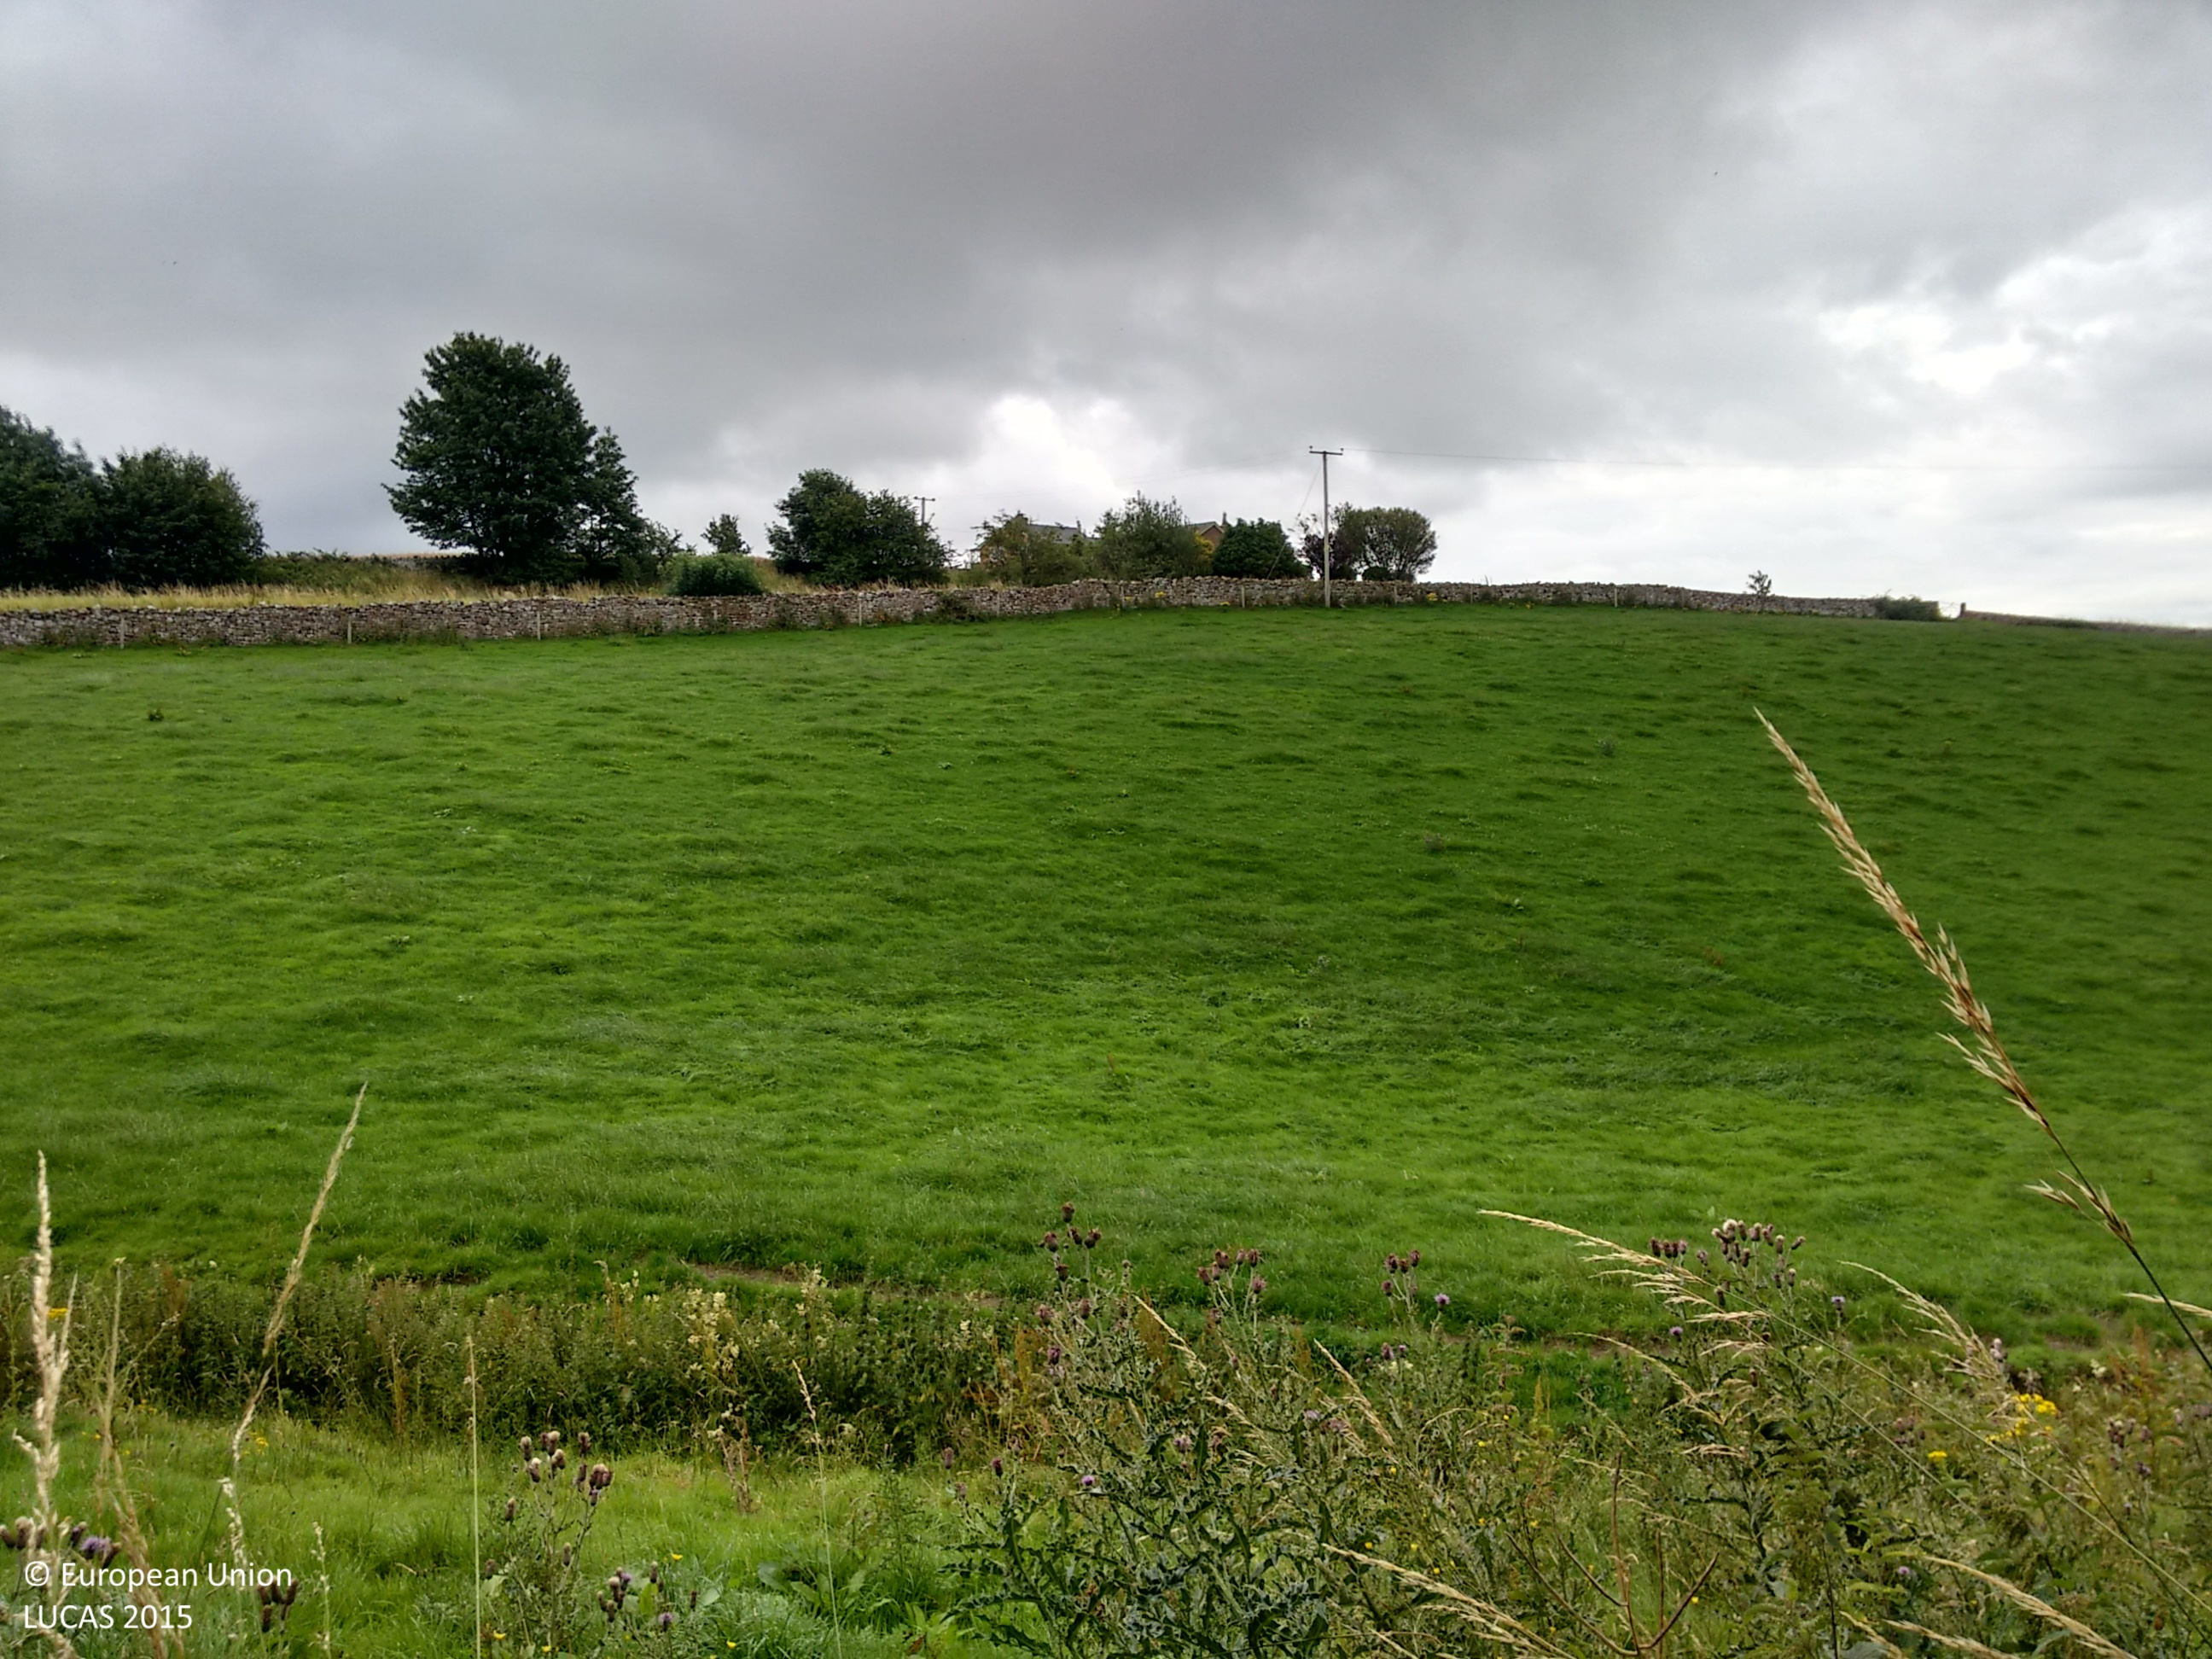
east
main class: Grassland
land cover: Grassland without tree/shrub cover
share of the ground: > 75 %
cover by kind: herbaceous plants 100 %
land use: Agriculture (excluding fallow land and kitchen gardens)
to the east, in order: Grassland without tree/shrub cover; Electric lines; Grassland without tree/shrub cover; Dry stone walls; Grassland without tree/shrub cover; Paved roads, cycling and walking lanes; Grassland with sparse tree/shrub cover; Artificial constructions; Rape and turnip rape
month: August
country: GB
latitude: 54.7424
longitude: -2.7901
